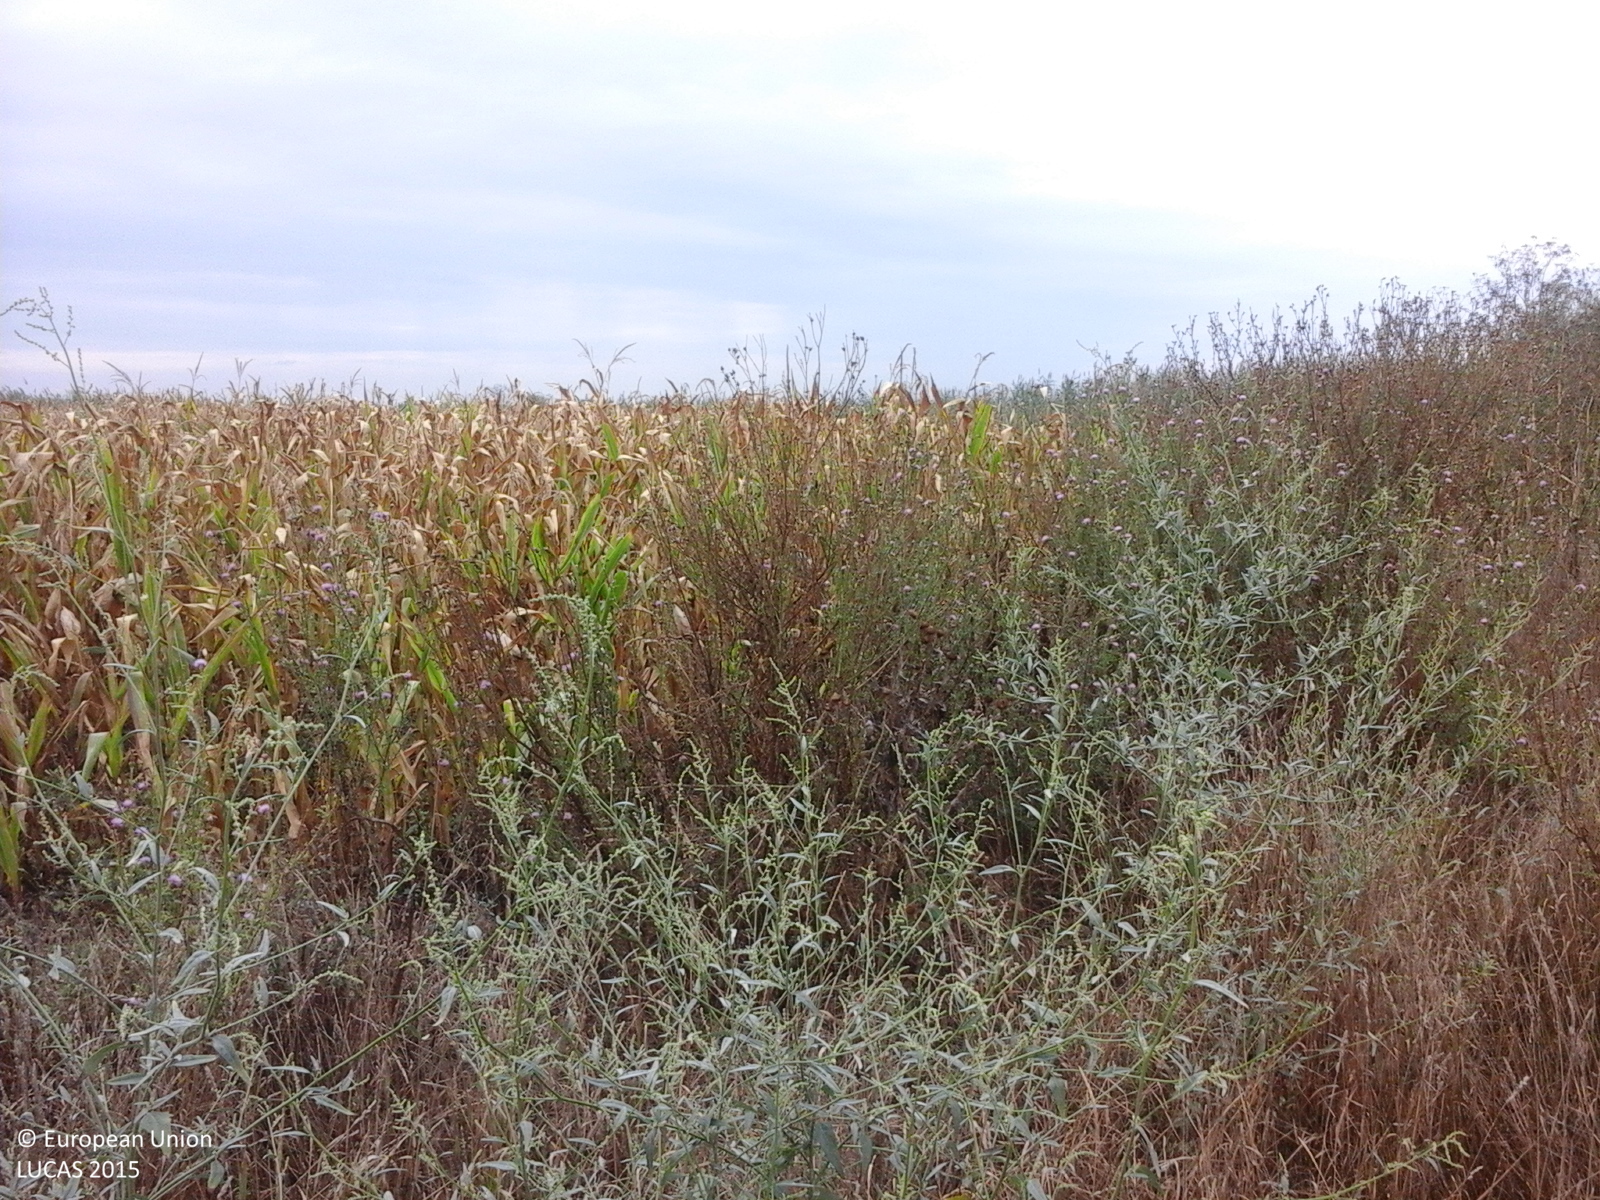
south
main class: Cropland
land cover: Maize
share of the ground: > 75 %
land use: Agriculture (excluding fallow land and kitchen gardens)
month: August
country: RO
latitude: 45.7854
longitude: 20.7921
